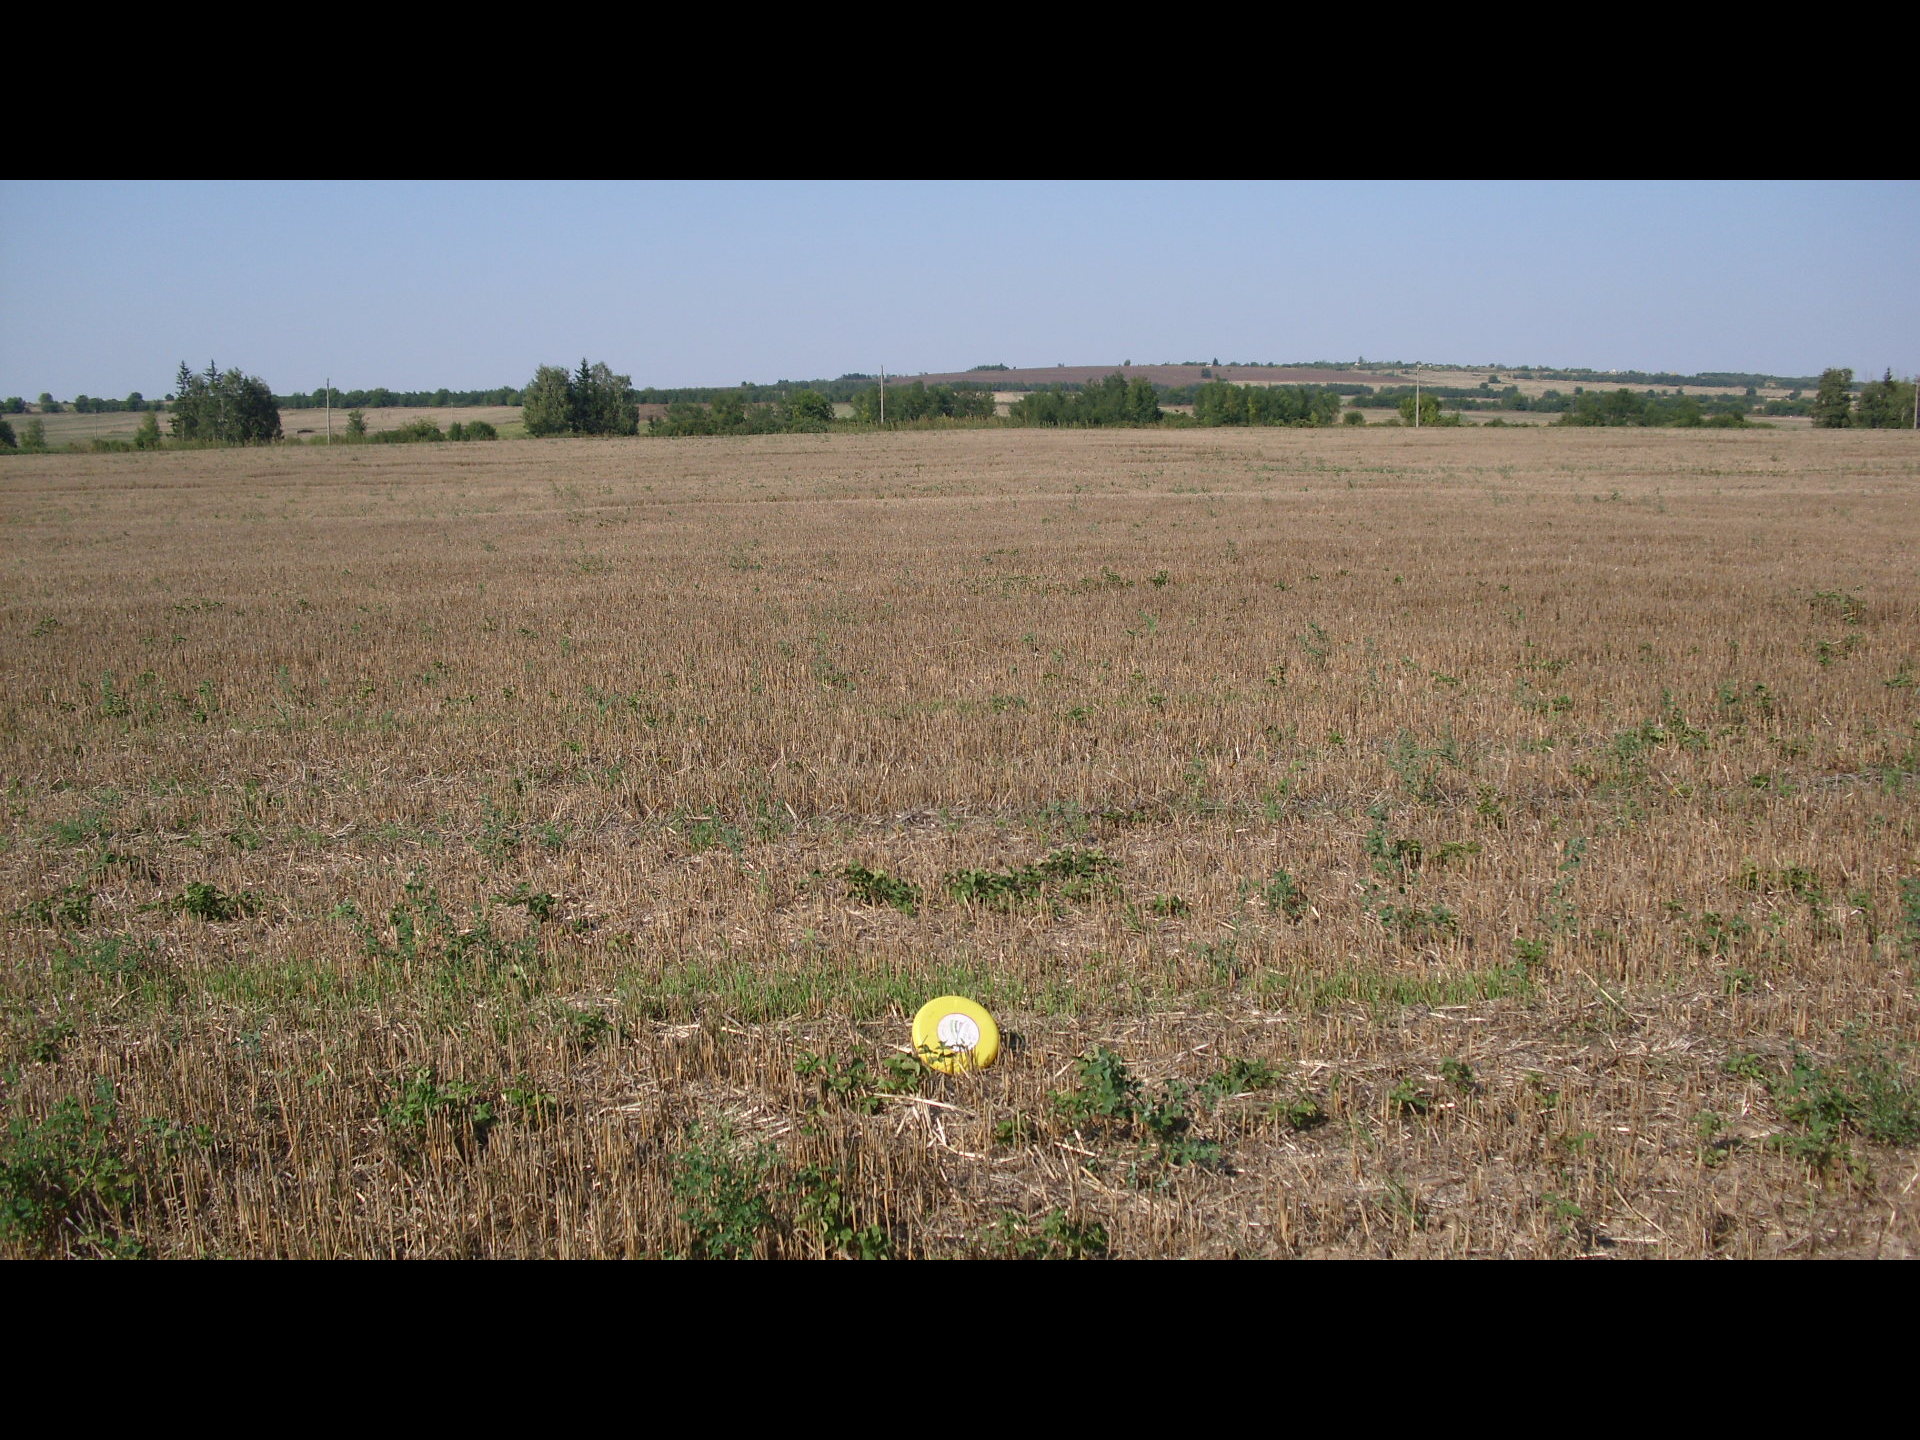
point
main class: Cropland
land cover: Common wheat
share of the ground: 50 - 75 %
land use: Agriculture (excluding fallow land and kitchen gardens)
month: August
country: BG
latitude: 44.1145
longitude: 22.6954
